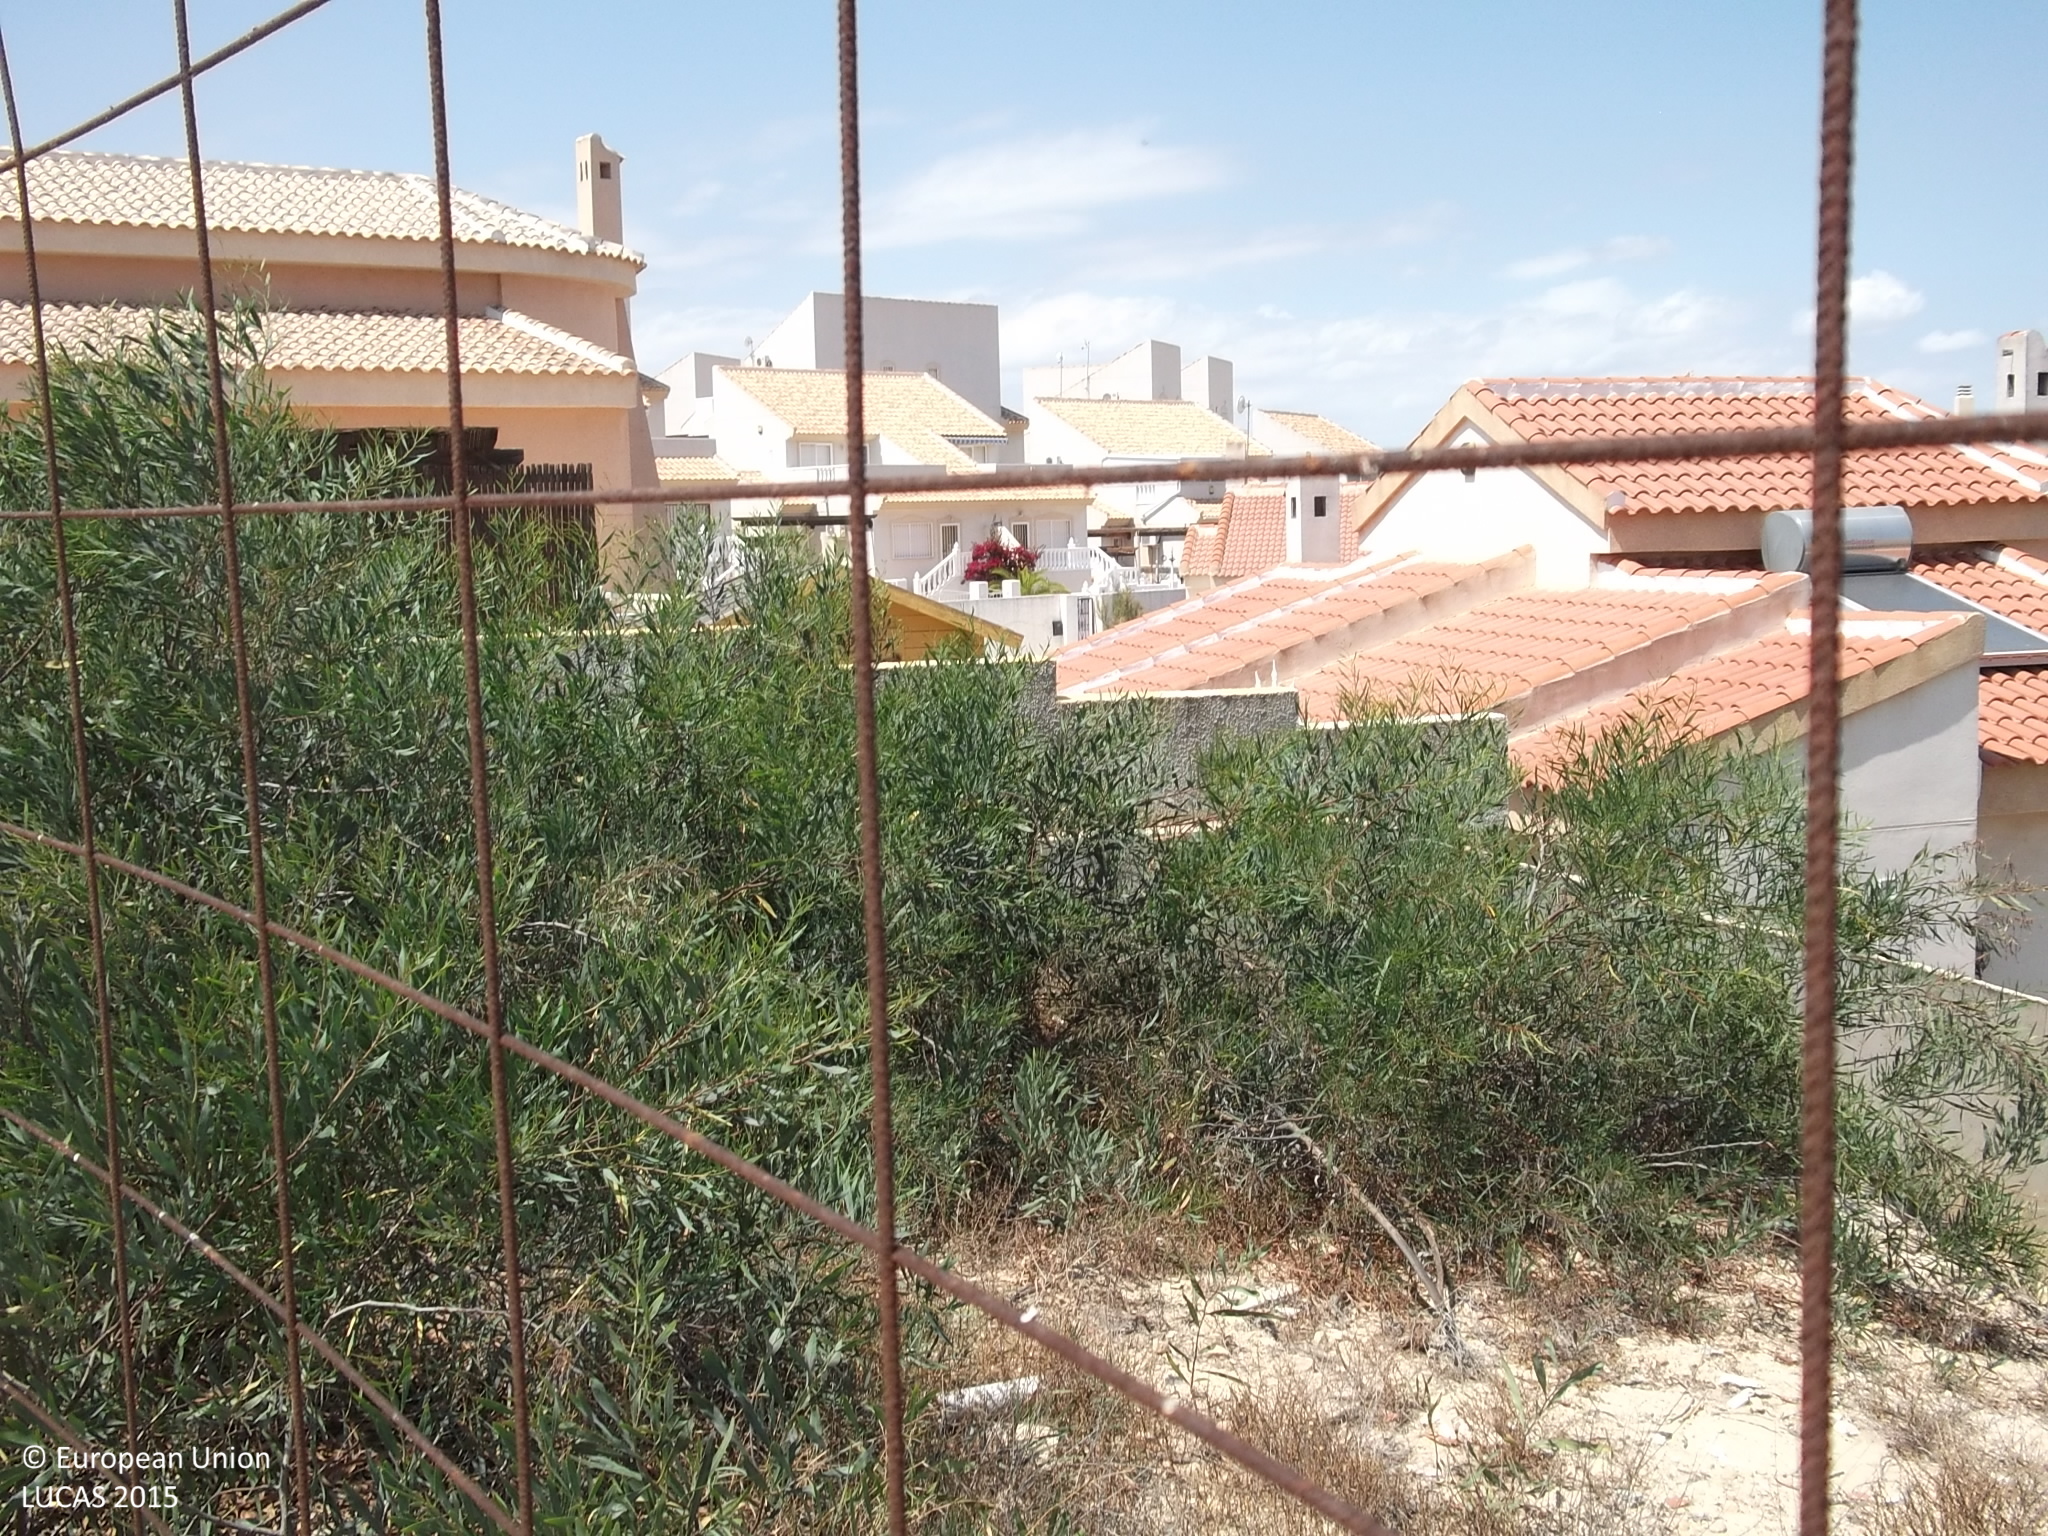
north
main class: Shrubland
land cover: Shrubland with sparse tree cover
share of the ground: 10 - 25 %
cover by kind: consolidated bare surface 50 %, herbaceous plants 30 %, shrubs 15 %, broadleaved forest trees 5 %
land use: Residential
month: May
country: ES
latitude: 38.0730
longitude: -0.7099
